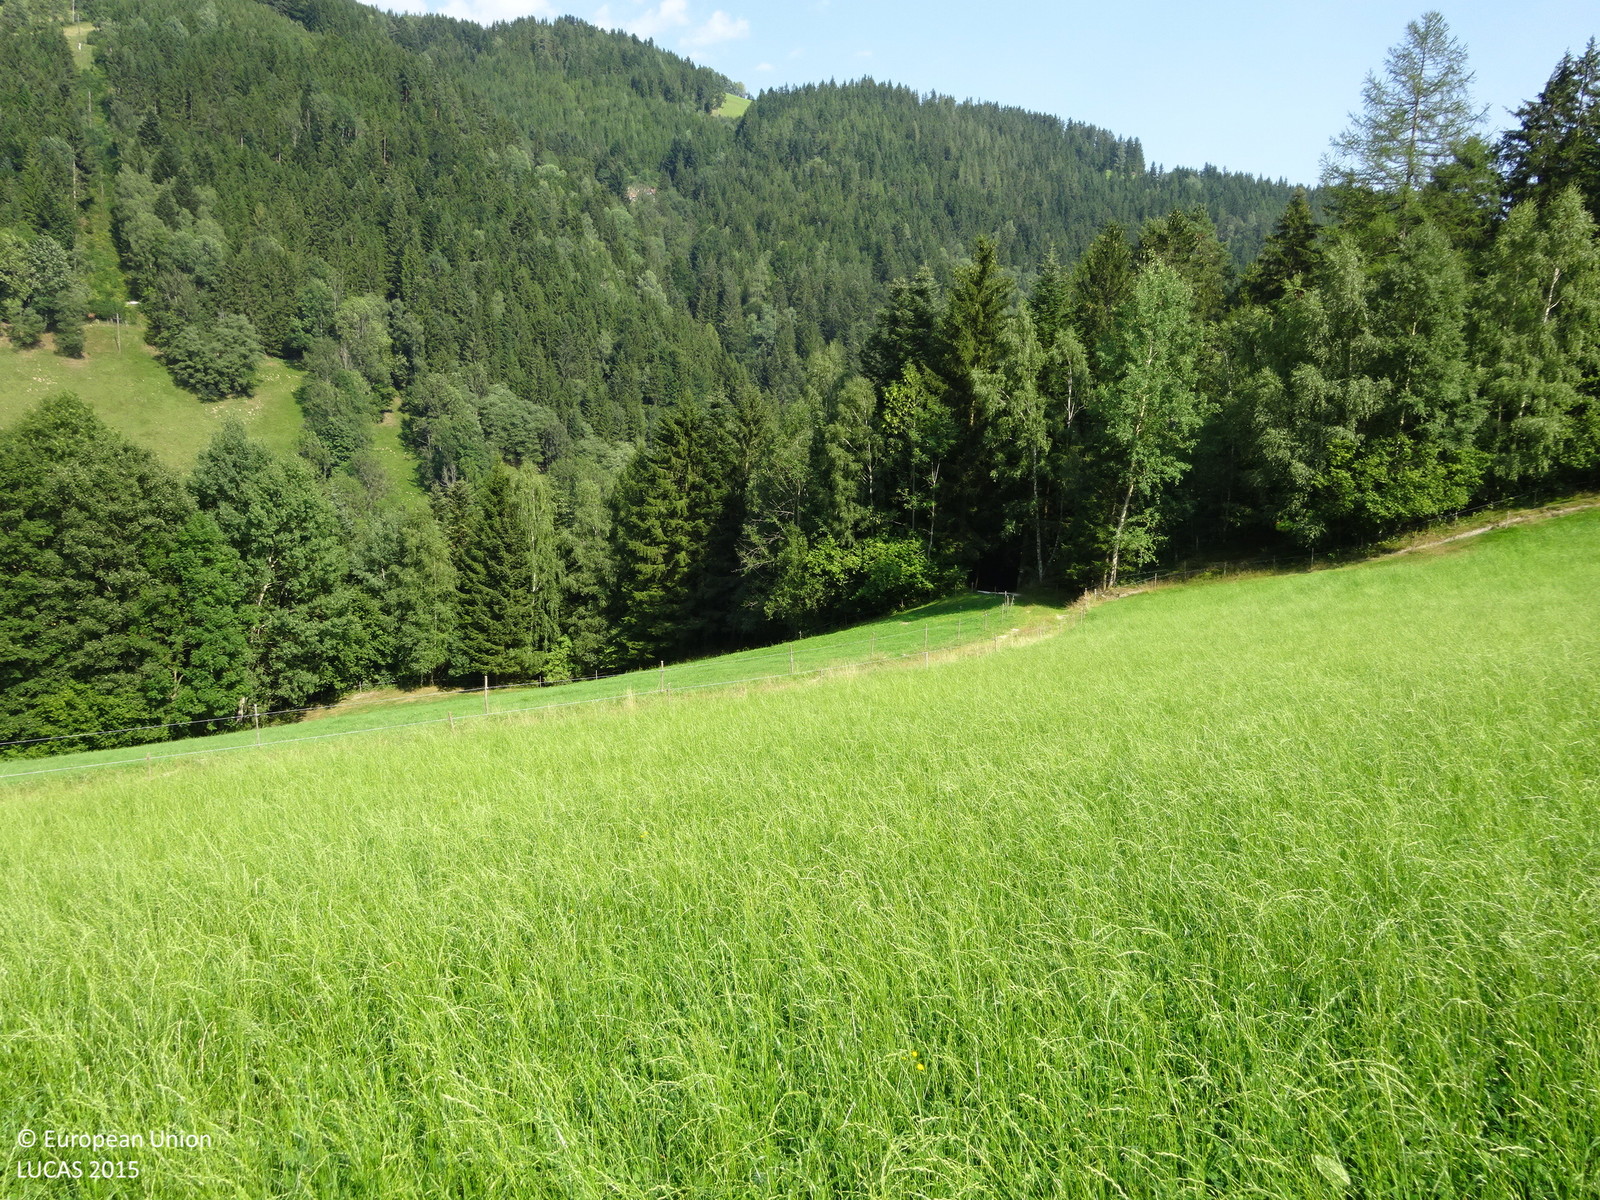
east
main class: Grassland
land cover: Grassland without tree/shrub cover
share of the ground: > 75 %
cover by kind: herbaceous plants 100 %
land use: Agriculture (excluding fallow land and kitchen gardens)
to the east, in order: Grassland without tree/shrub cover; Fences; Tracks; Fences; Grassland without tree/shrub cover; Fences; Other mixed woodland; Broadleaved woodland; Tracks; Shrubland without tree cover; Fences; Spruce dominated coniferous woodland; Broadleaved woodland; Inland fresh running water; Broadleaved woodland; Grassland without tree/shrub cover; Paved roads, cycling and walking lanes
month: August
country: AT
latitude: 47.4272
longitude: 15.6884
